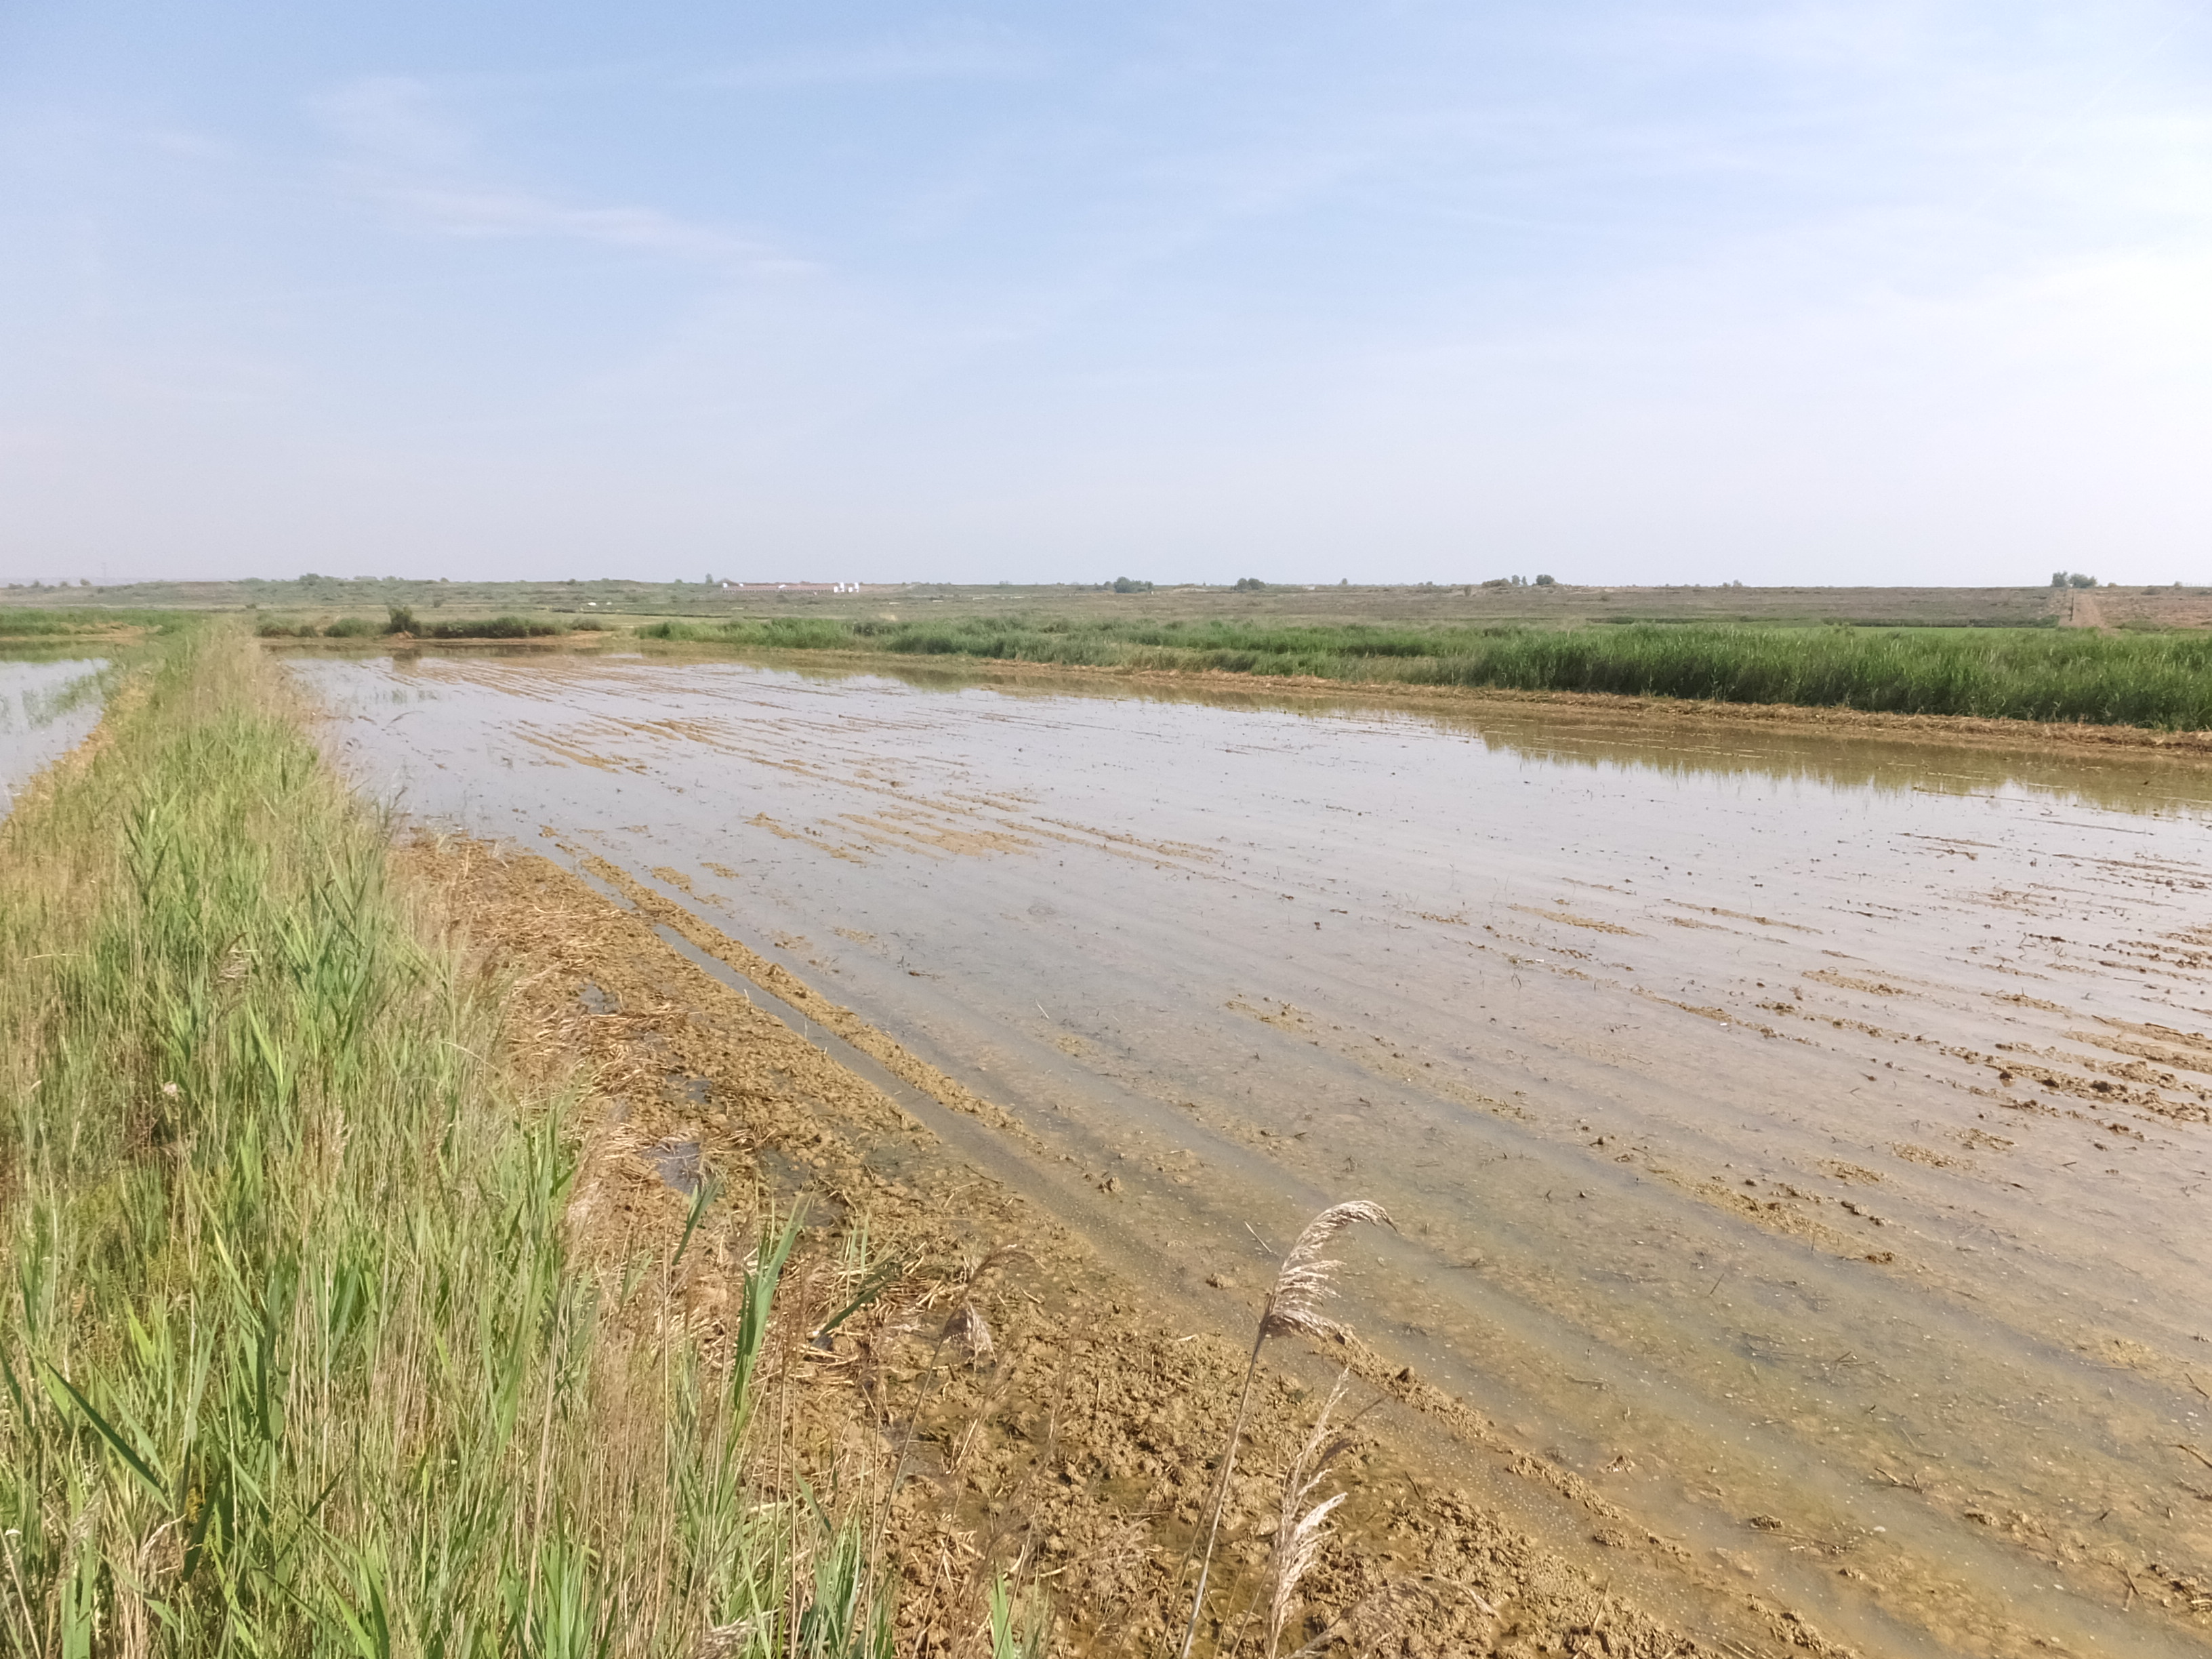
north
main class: Cropland
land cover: Rice
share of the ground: < 10 %
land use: Agriculture (excluding fallow land and kitchen gardens)
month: June
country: ES
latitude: 41.7280
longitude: 0.0660
